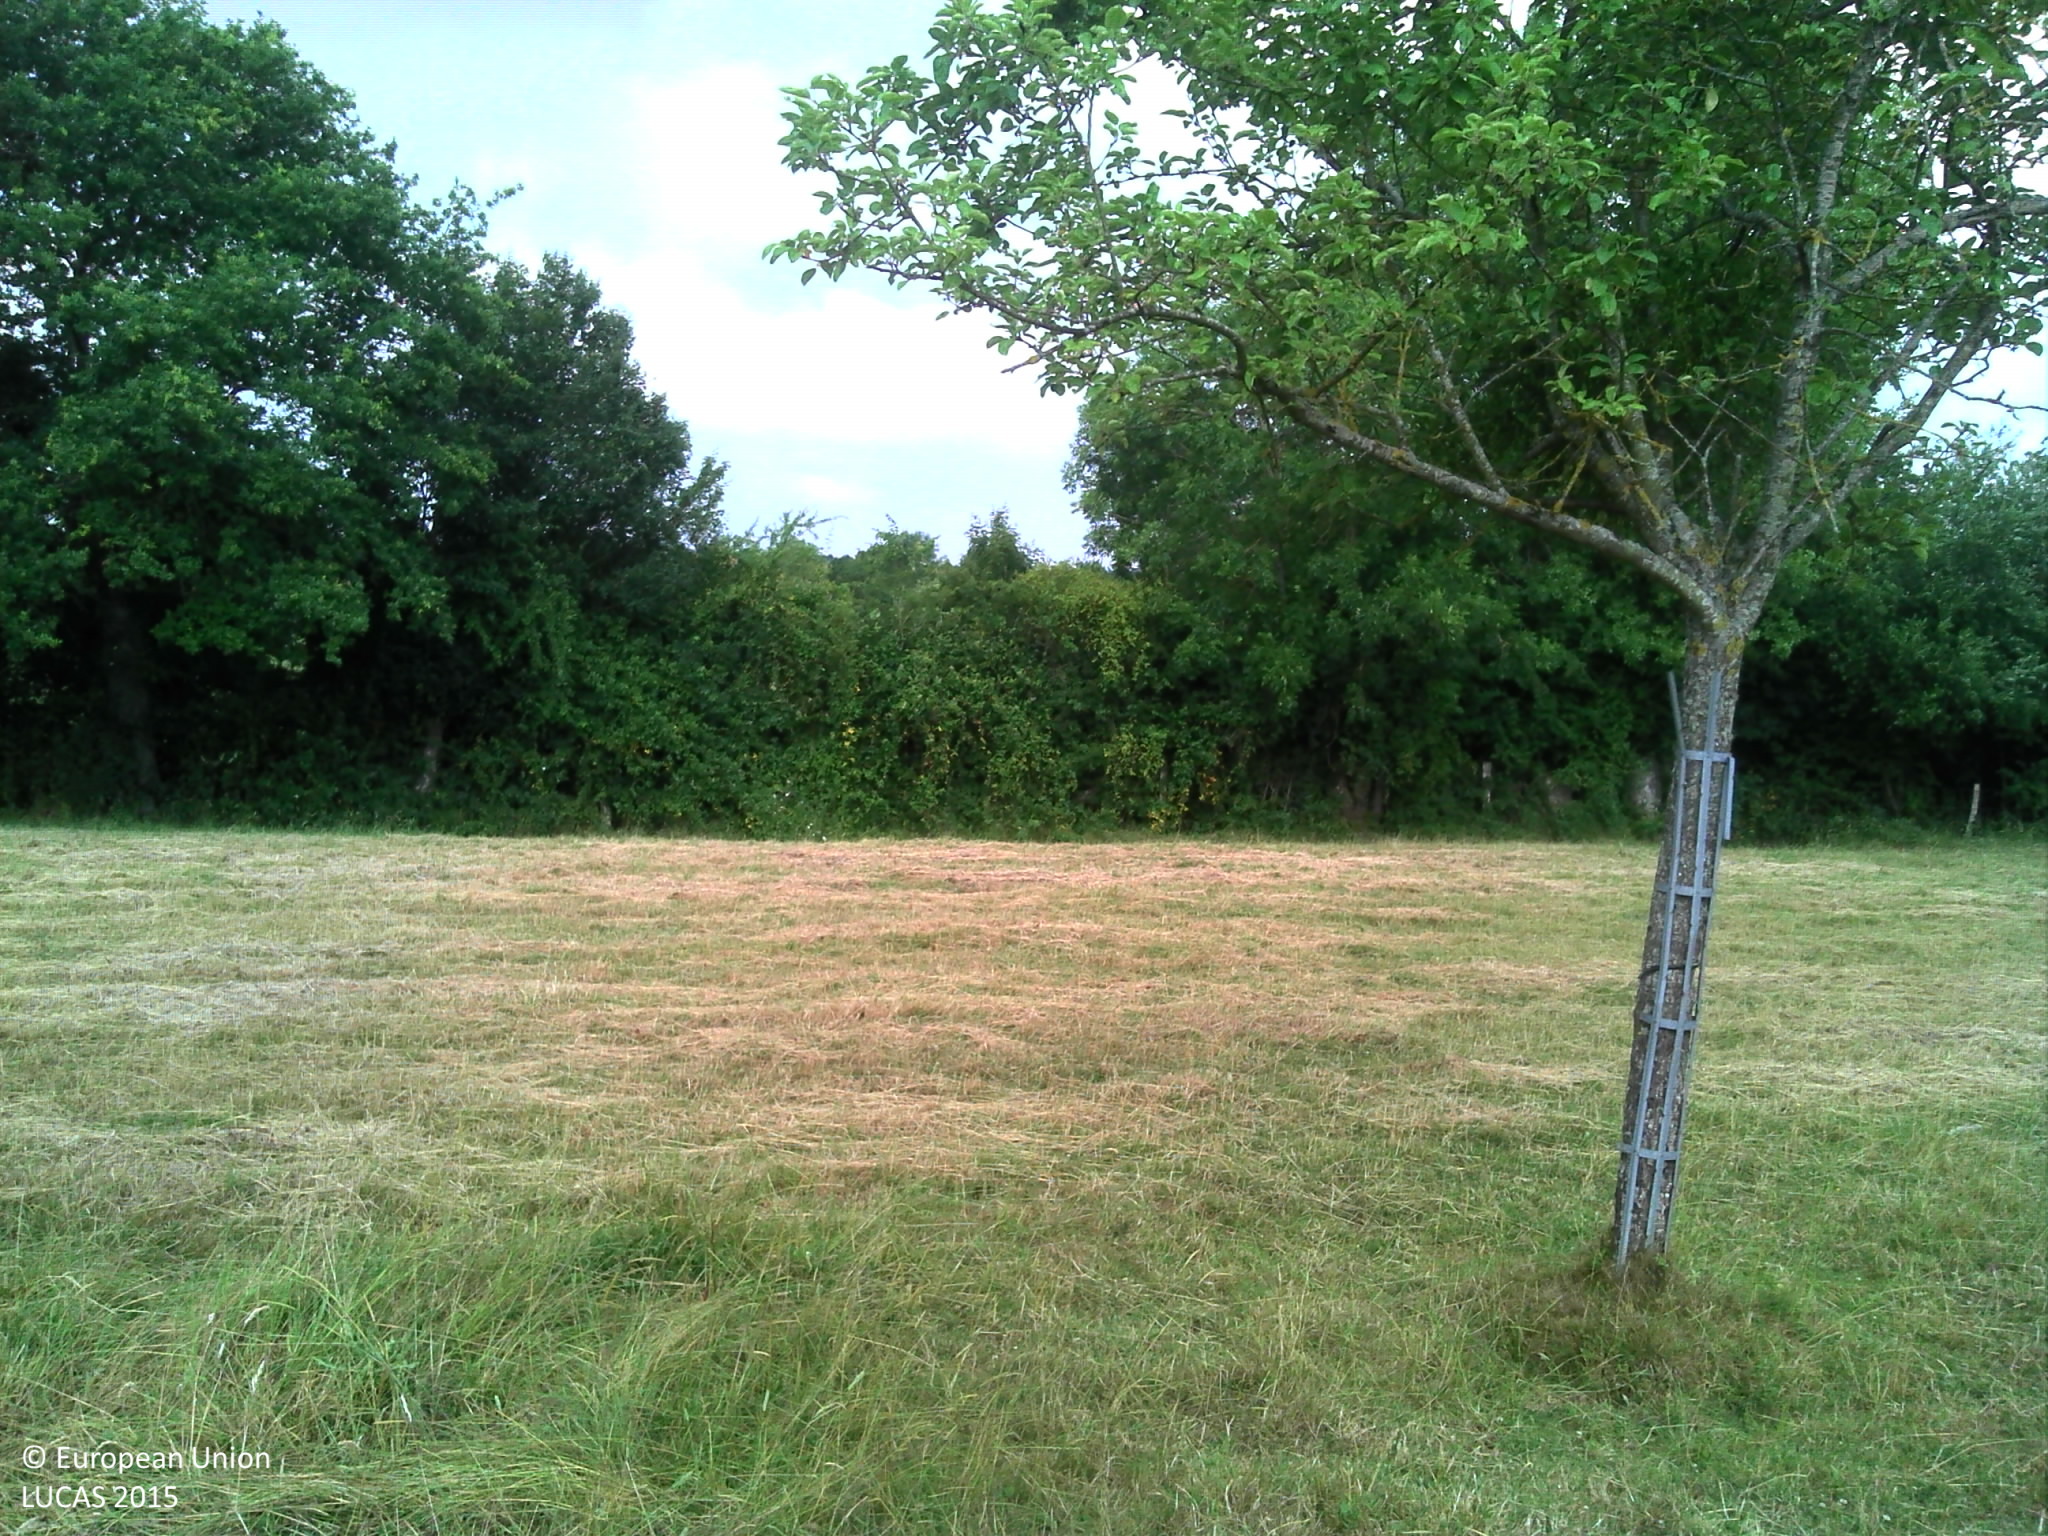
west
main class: Cropland
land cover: Apple fruit
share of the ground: 10 - 25 %
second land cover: Grassland without tree/shrub cover
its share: > 75 %
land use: Agriculture (excluding fallow land and kitchen gardens)
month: July
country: FR
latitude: 48.9499
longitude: 0.0425
